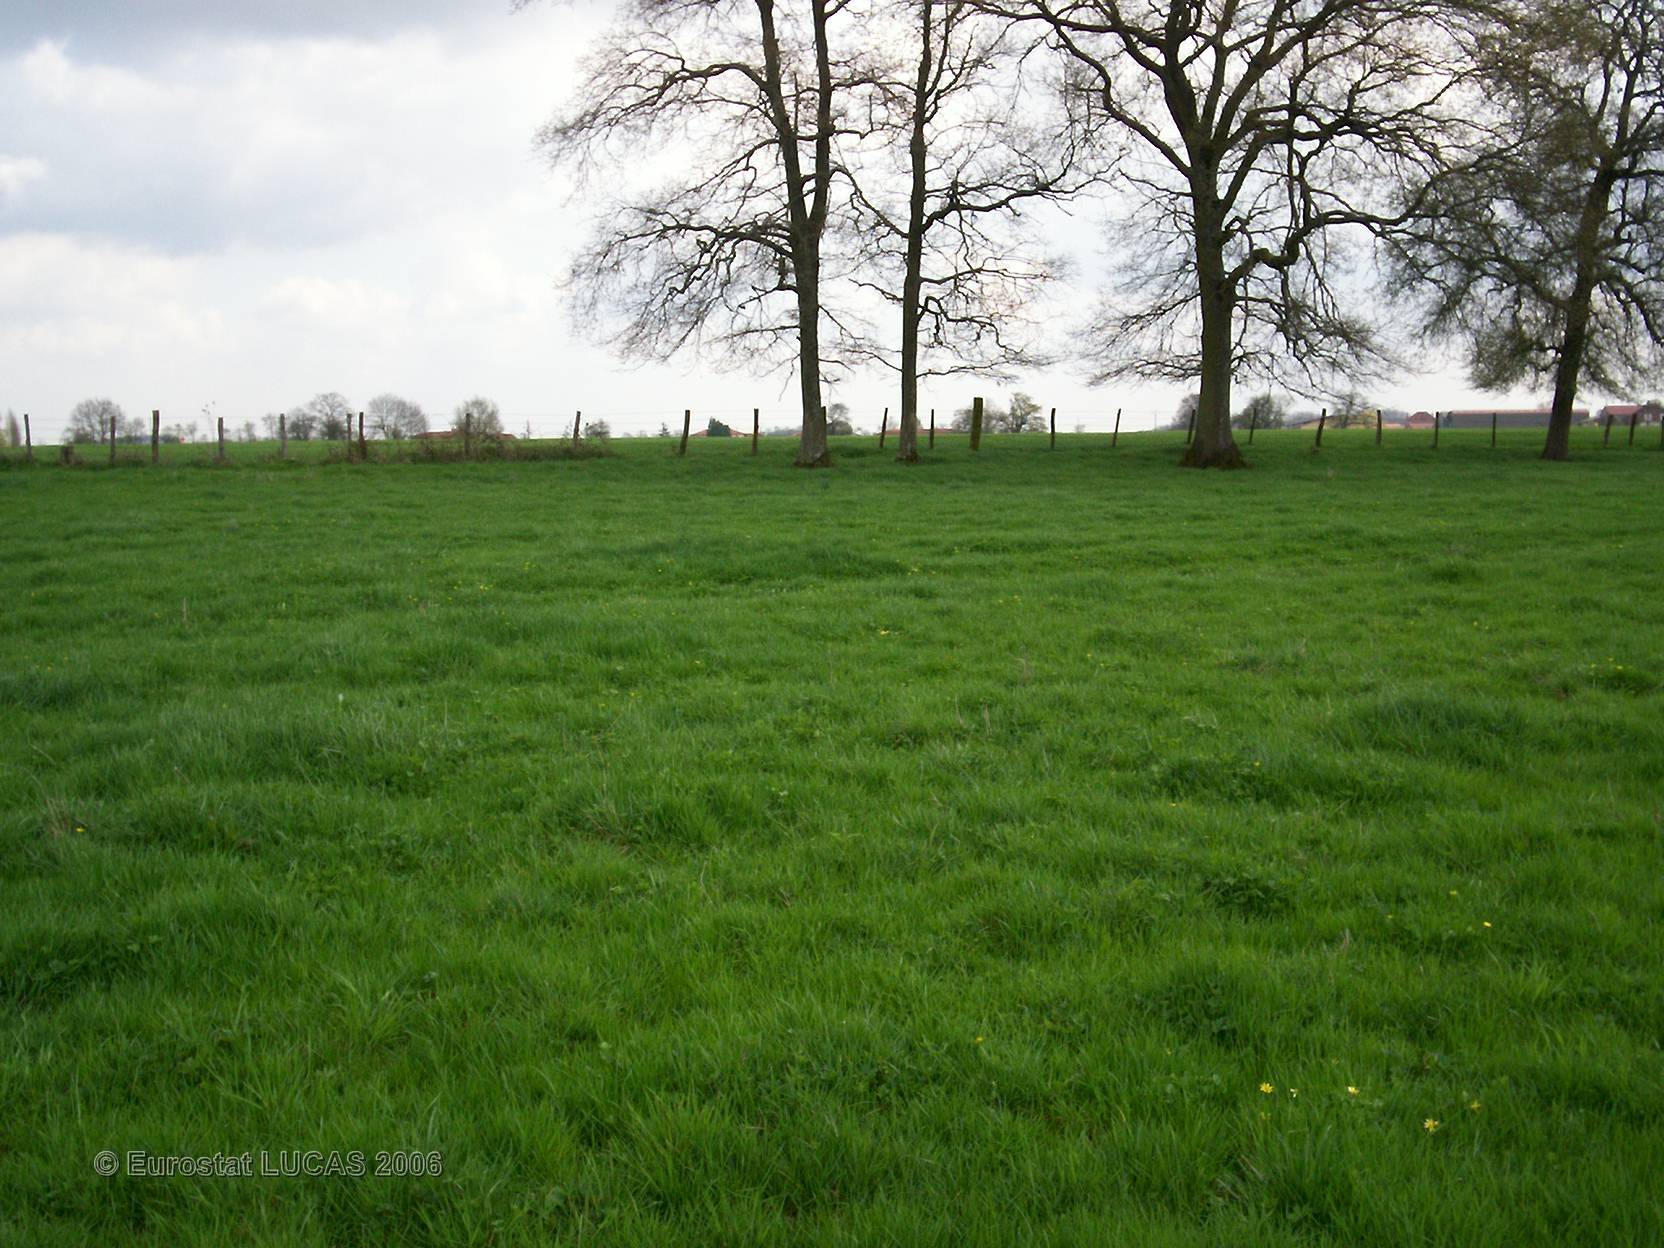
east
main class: Grassland
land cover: Grassland without tree/shrub cover
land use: Agriculture (excluding fallow land and kitchen gardens)
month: April
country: FR
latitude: 48.5264
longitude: 4.6490
